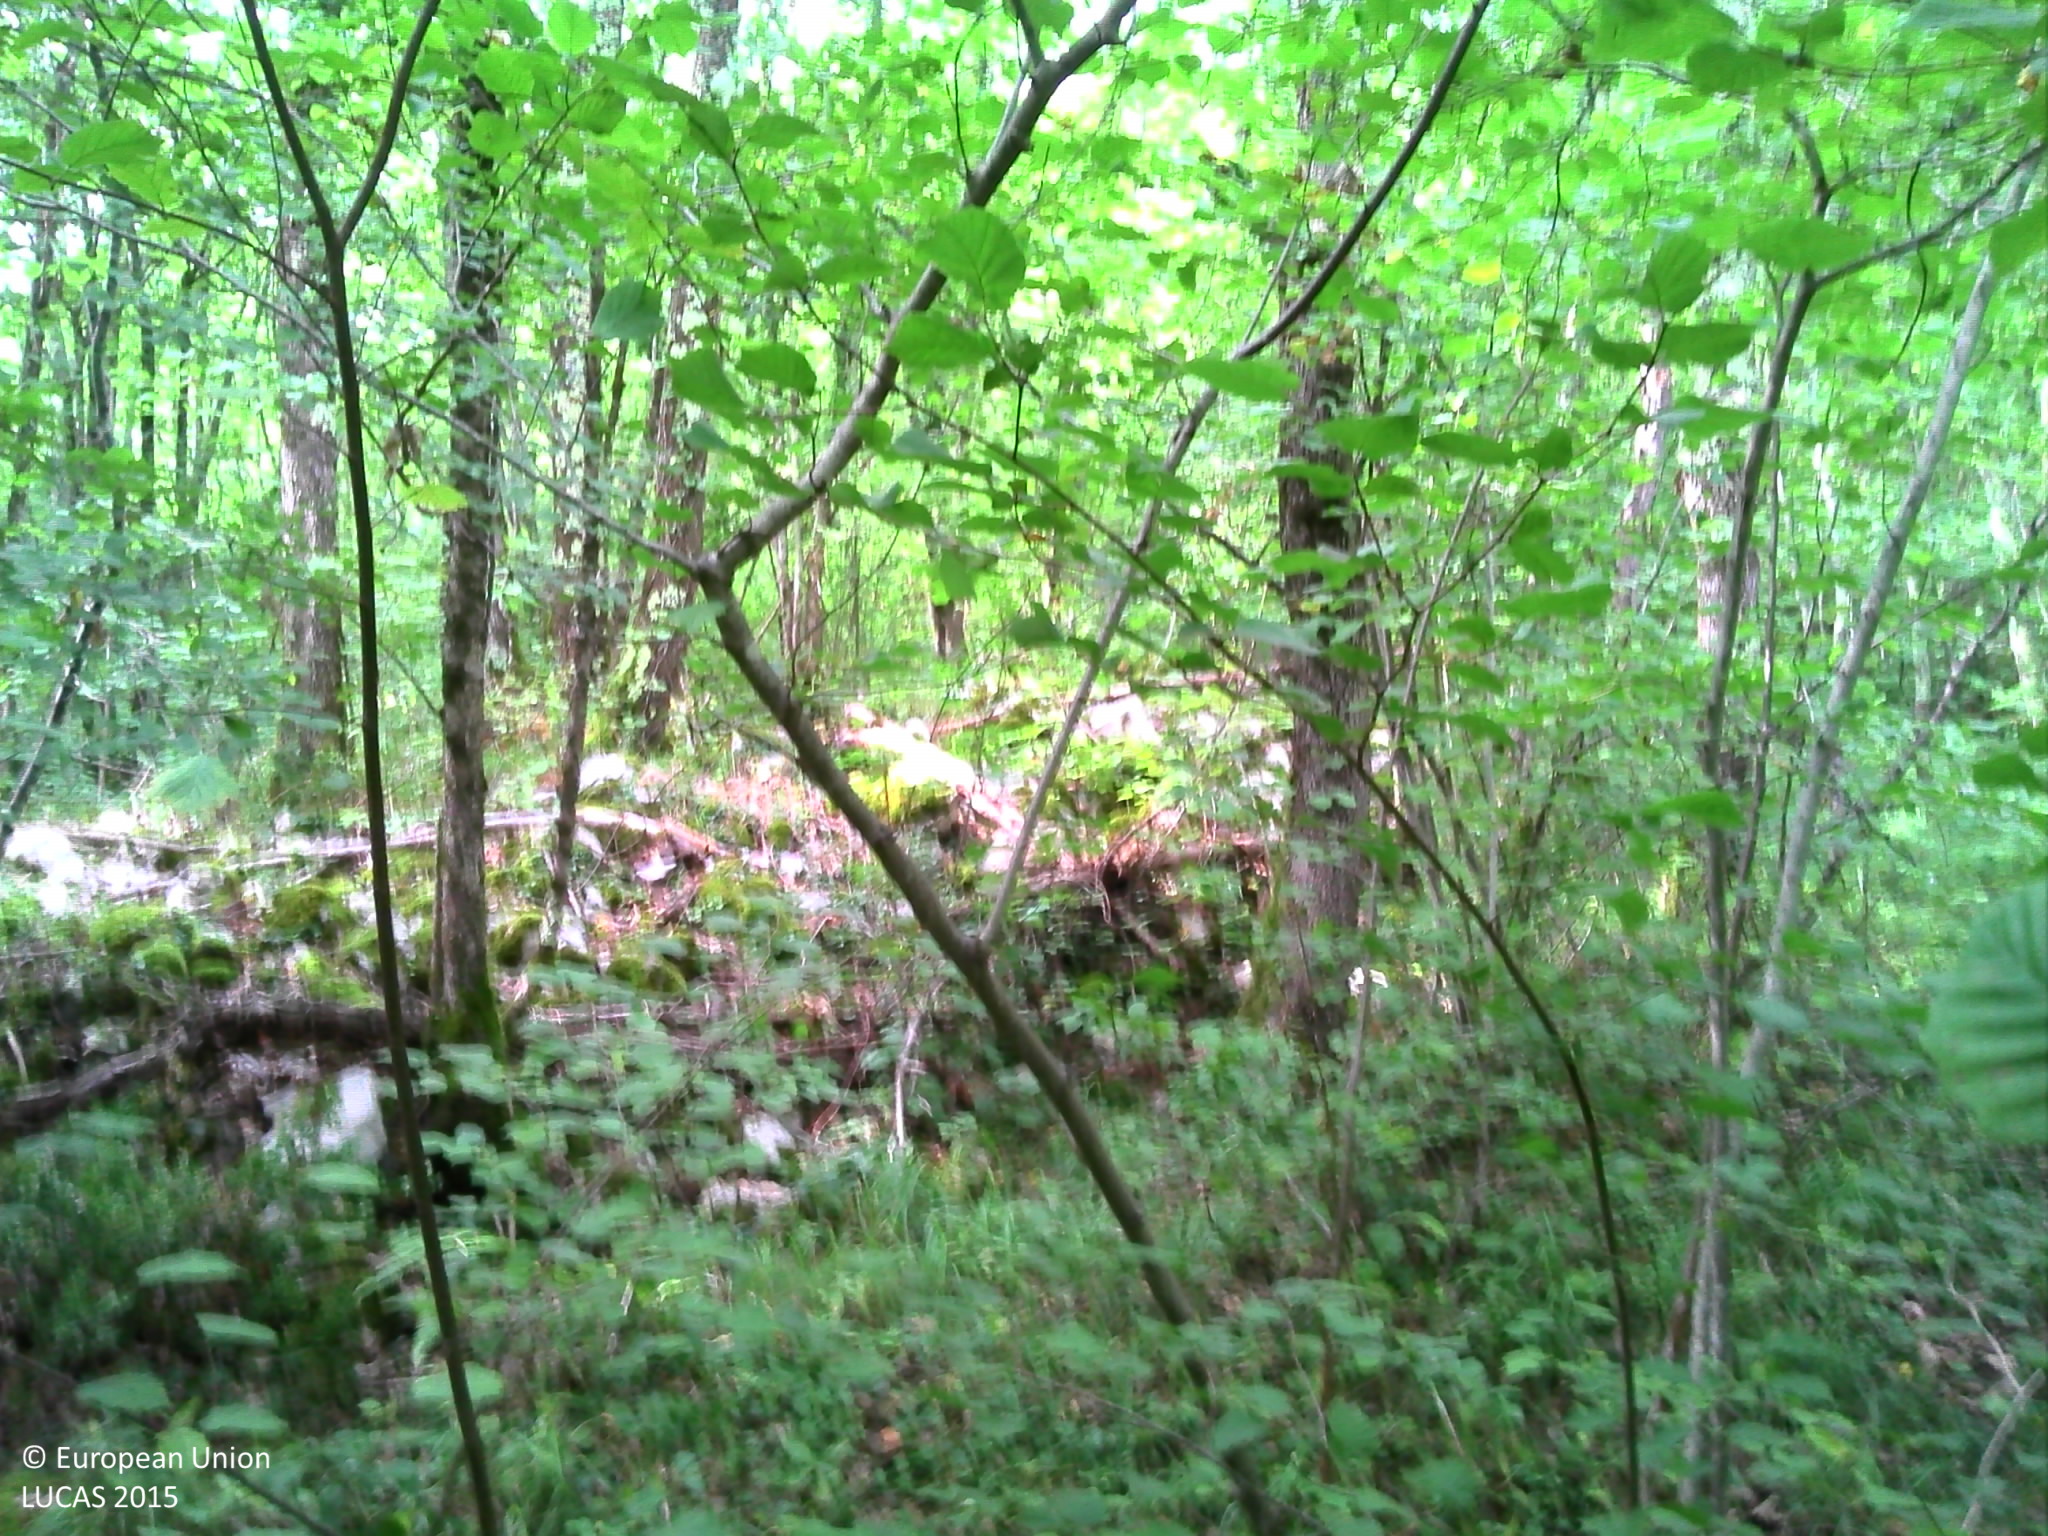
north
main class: Woodland
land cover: Broadleaved woodland
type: mesophytic deciduous forest
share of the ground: > 75 %
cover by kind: broadleaved forest trees 80 %, herbaceous plants 10 %, unconsolidated bare surface 10 %
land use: Semi-natural and natural areas not in use
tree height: > 5 m
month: August
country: FR
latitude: 42.9806
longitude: 1.6560
